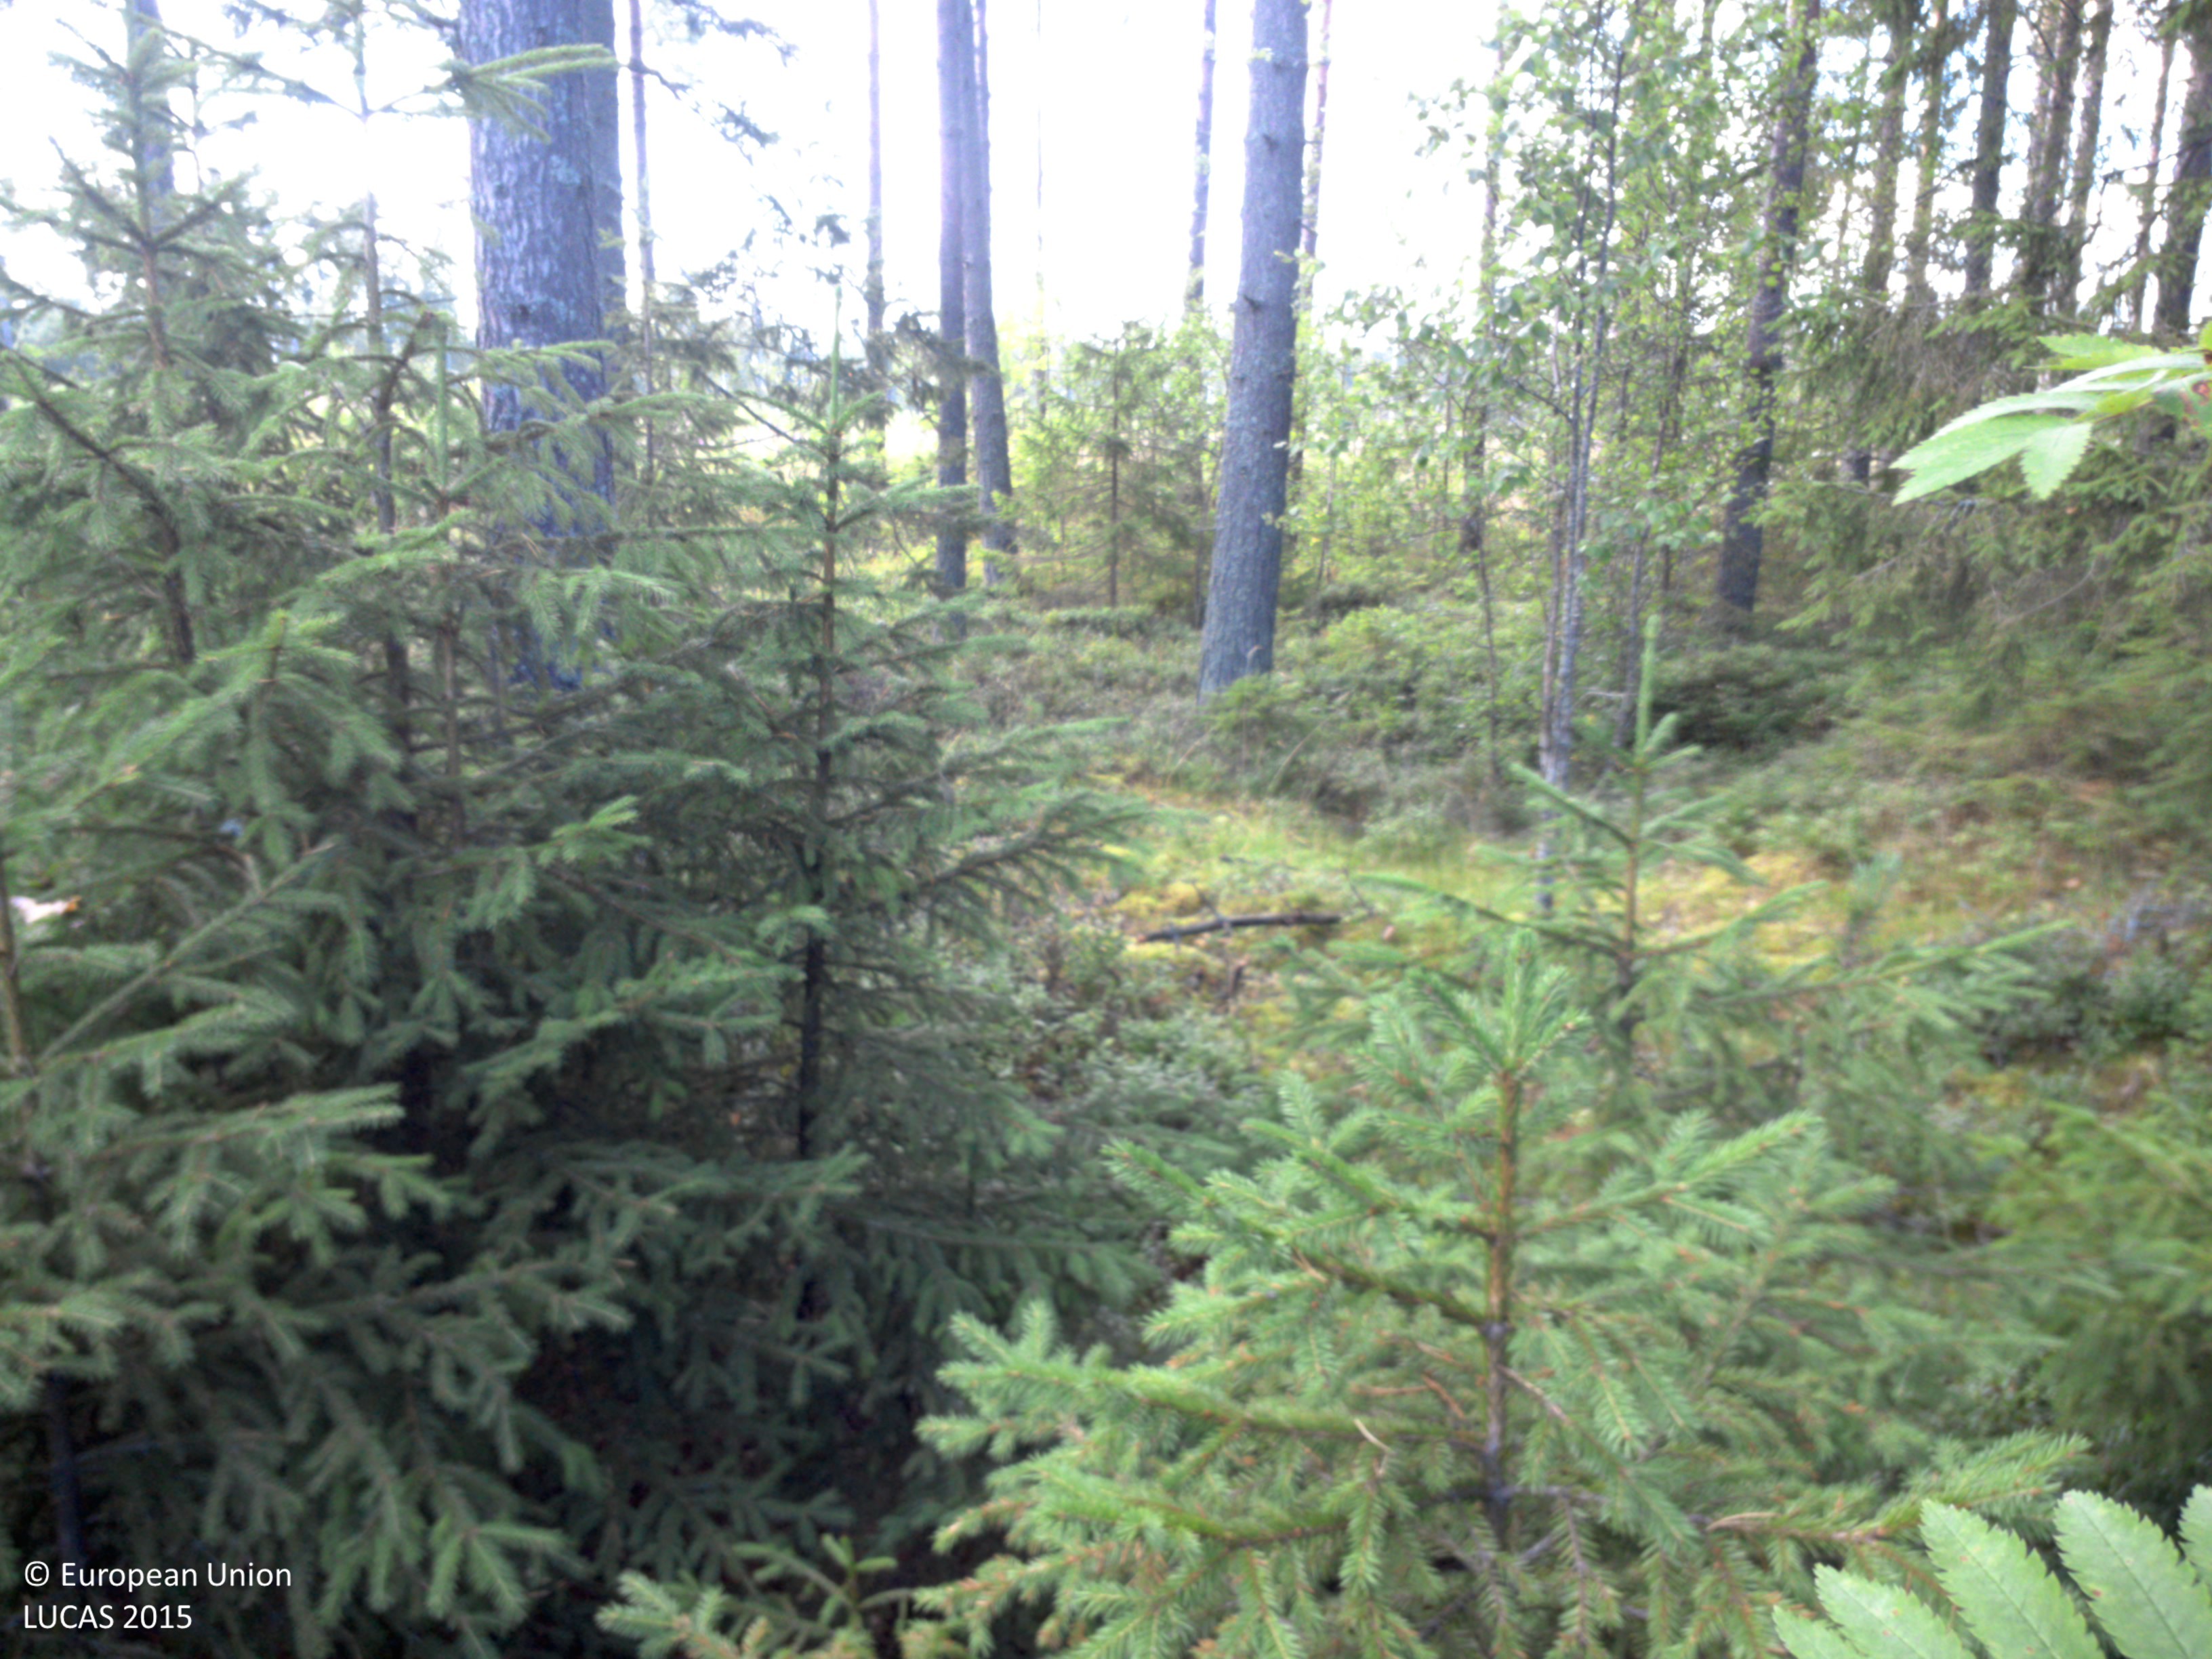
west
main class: Woodland
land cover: Other coniferous woodland
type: boreal forest
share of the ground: 50 - 75 %
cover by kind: coniferous forest trees 55 %, shrubs 25 %, broadleaved forest trees 10 %, herbaceous plants 10 %
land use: Forestry
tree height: > 5 m
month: July
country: SE
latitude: 63.5536
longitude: 19.4181
